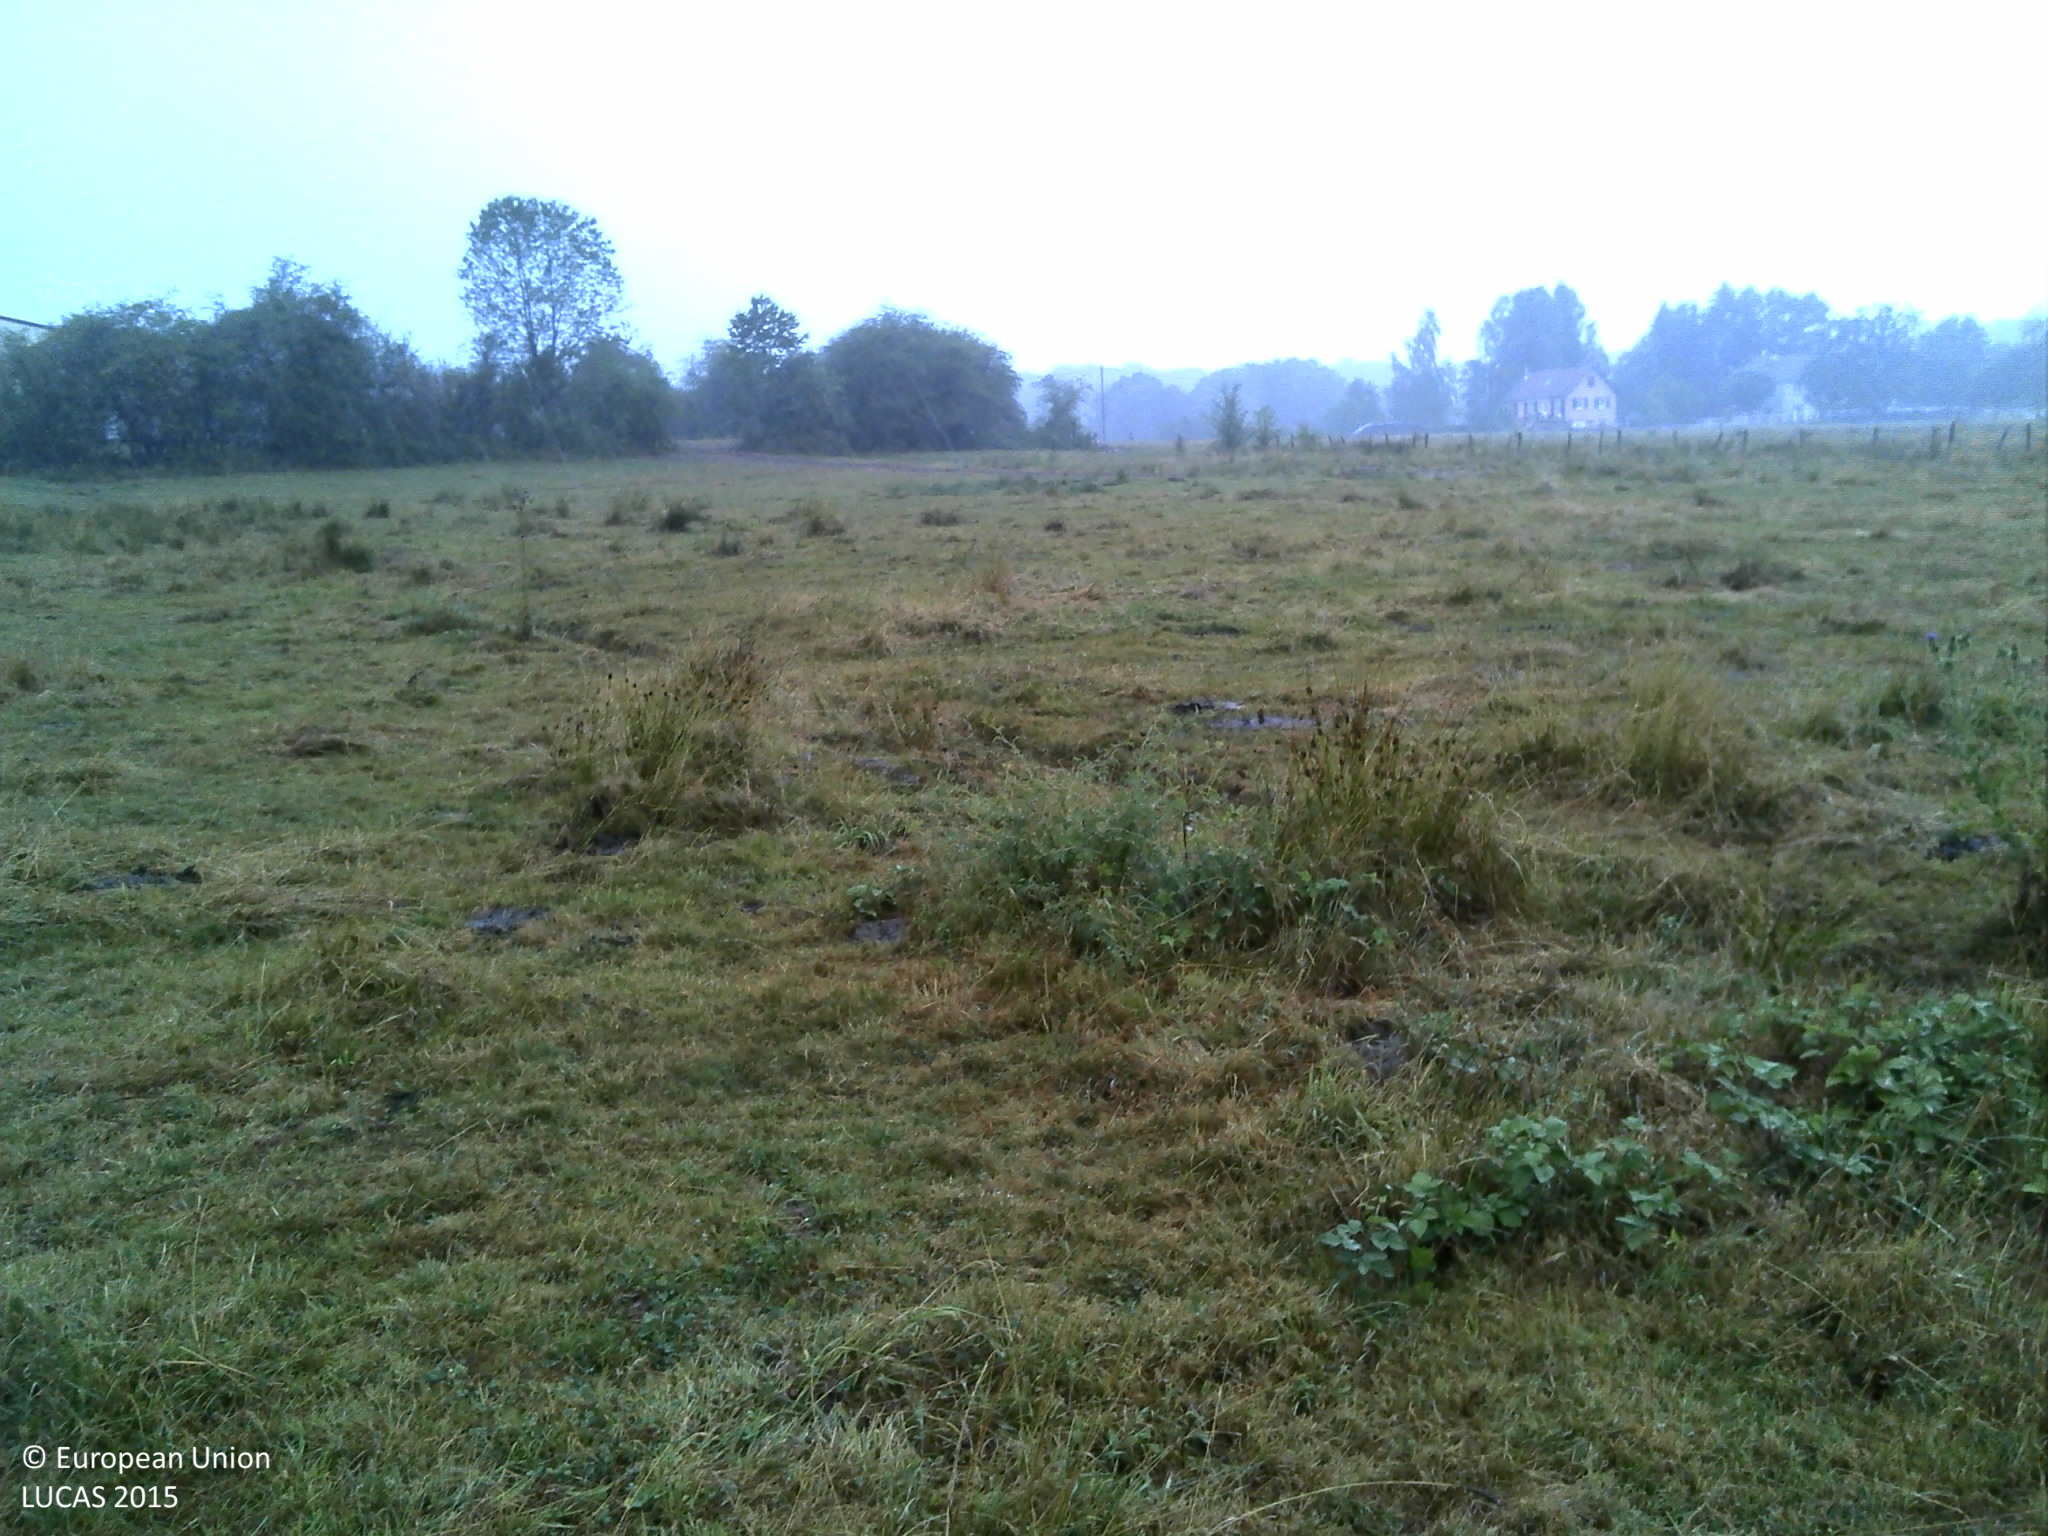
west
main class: Grassland
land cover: Grassland without tree/shrub cover
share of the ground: > 75 %
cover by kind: herbaceous plants 100 %
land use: Agriculture (excluding fallow land and kitchen gardens)
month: July
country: FR
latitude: 47.9621
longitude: 6.2643
